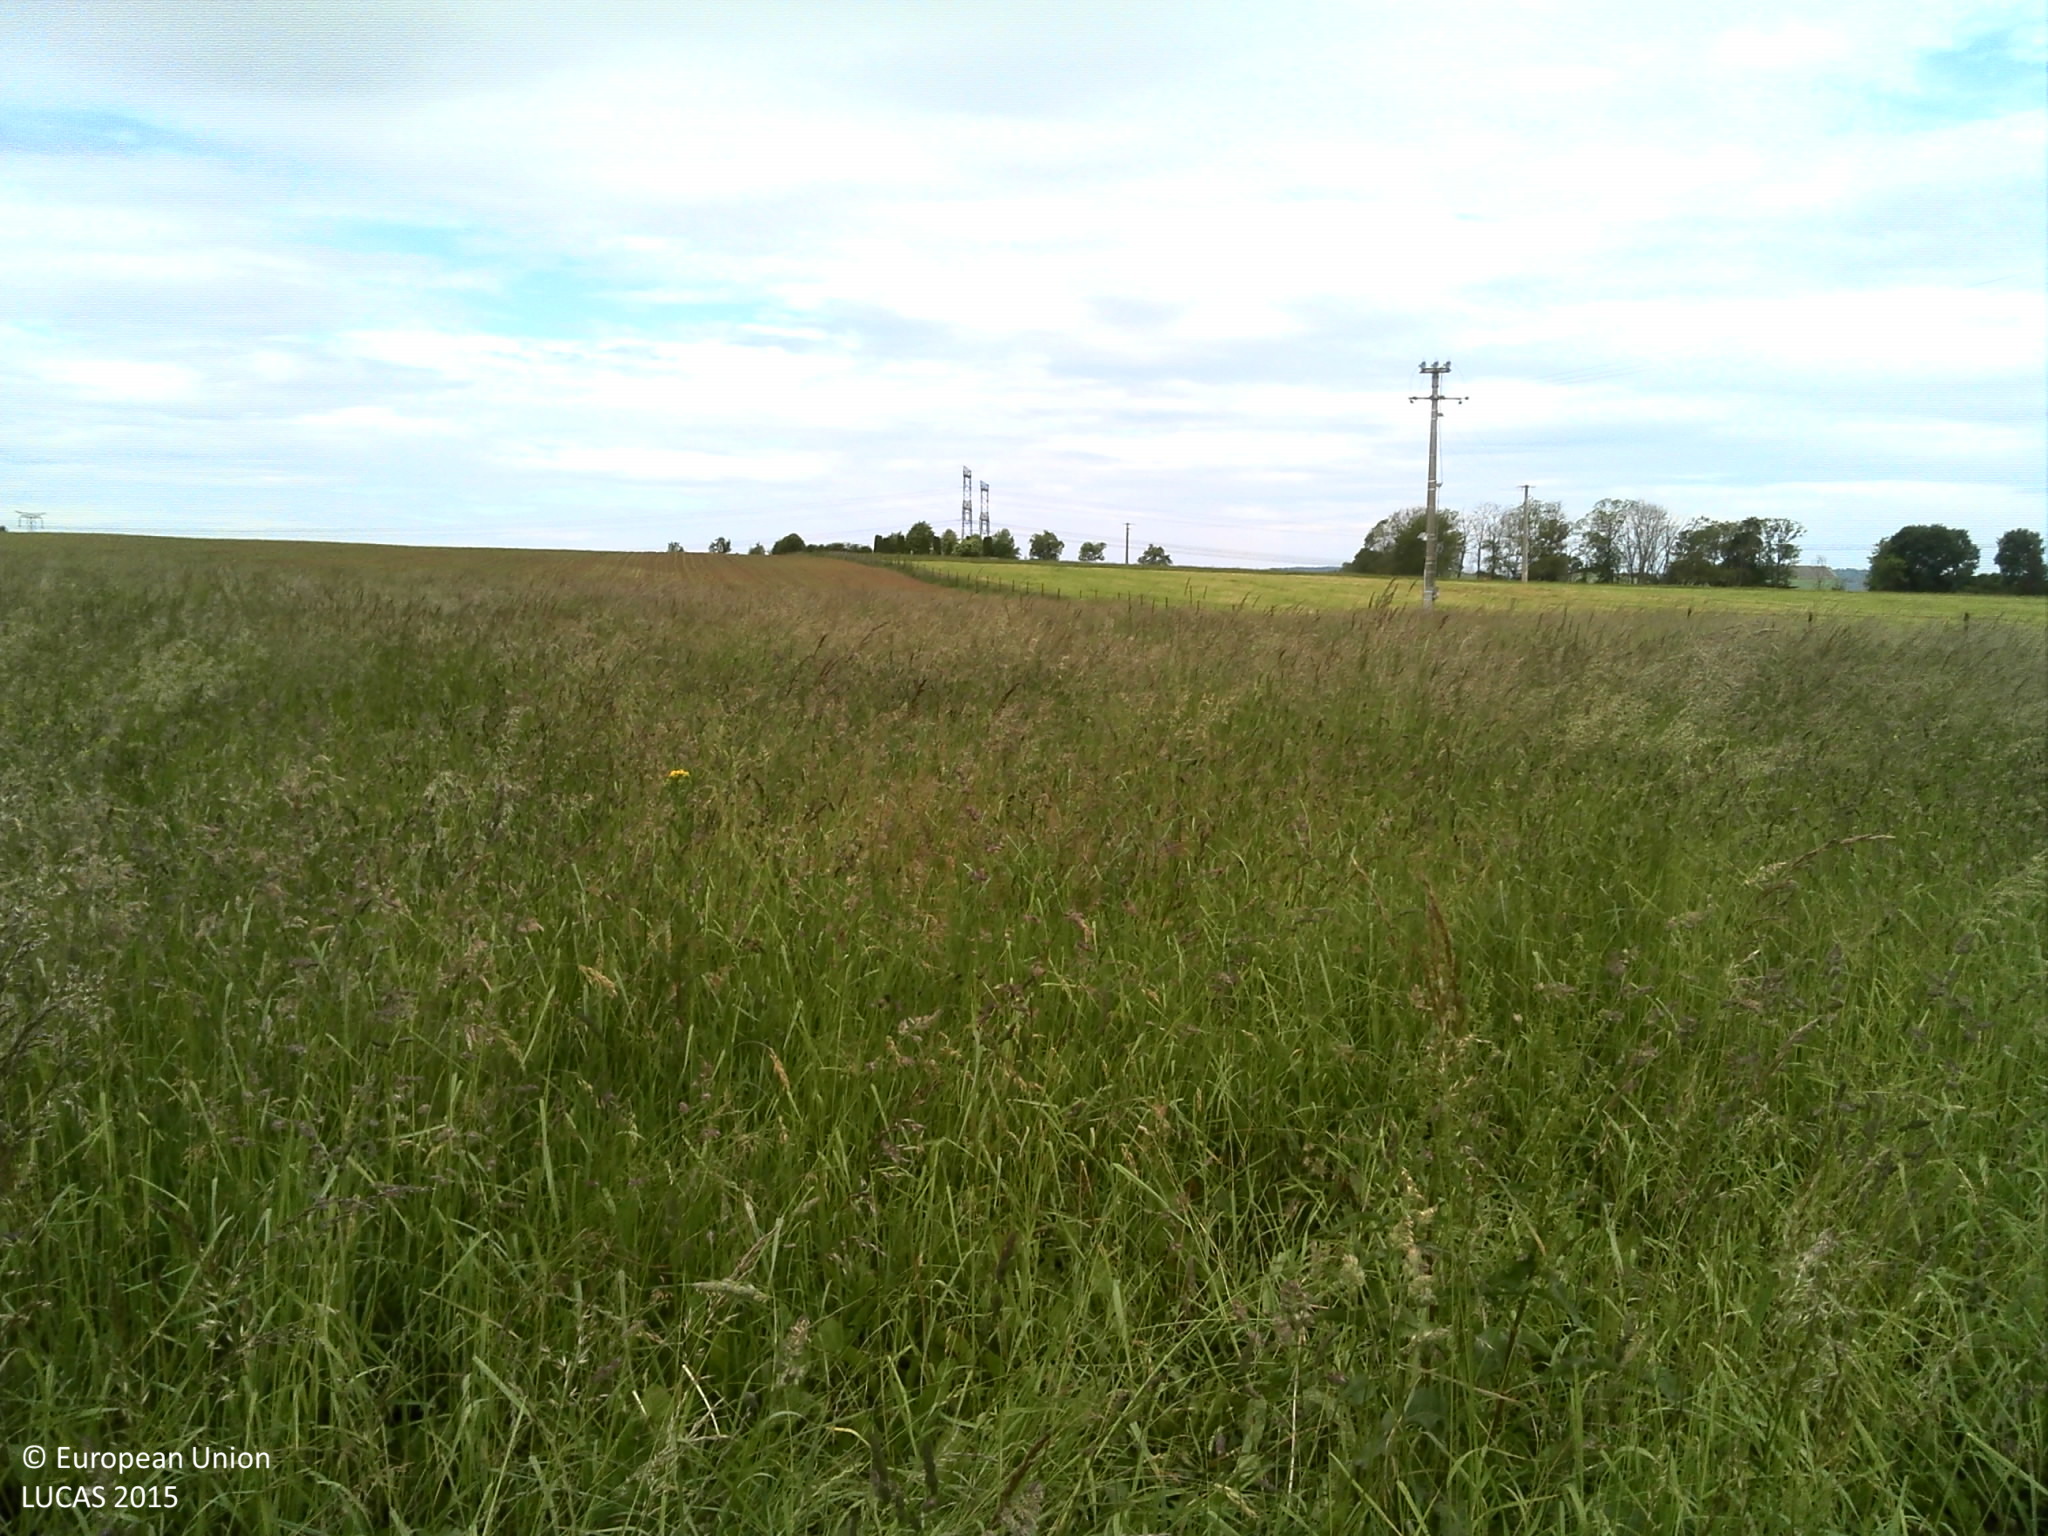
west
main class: Grassland
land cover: Grassland without tree/shrub cover
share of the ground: > 75 %
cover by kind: herbaceous plants 100 %
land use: Agriculture (excluding fallow land and kitchen gardens)
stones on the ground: < 10 %
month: June
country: FR
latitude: 48.9691
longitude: 6.2159
